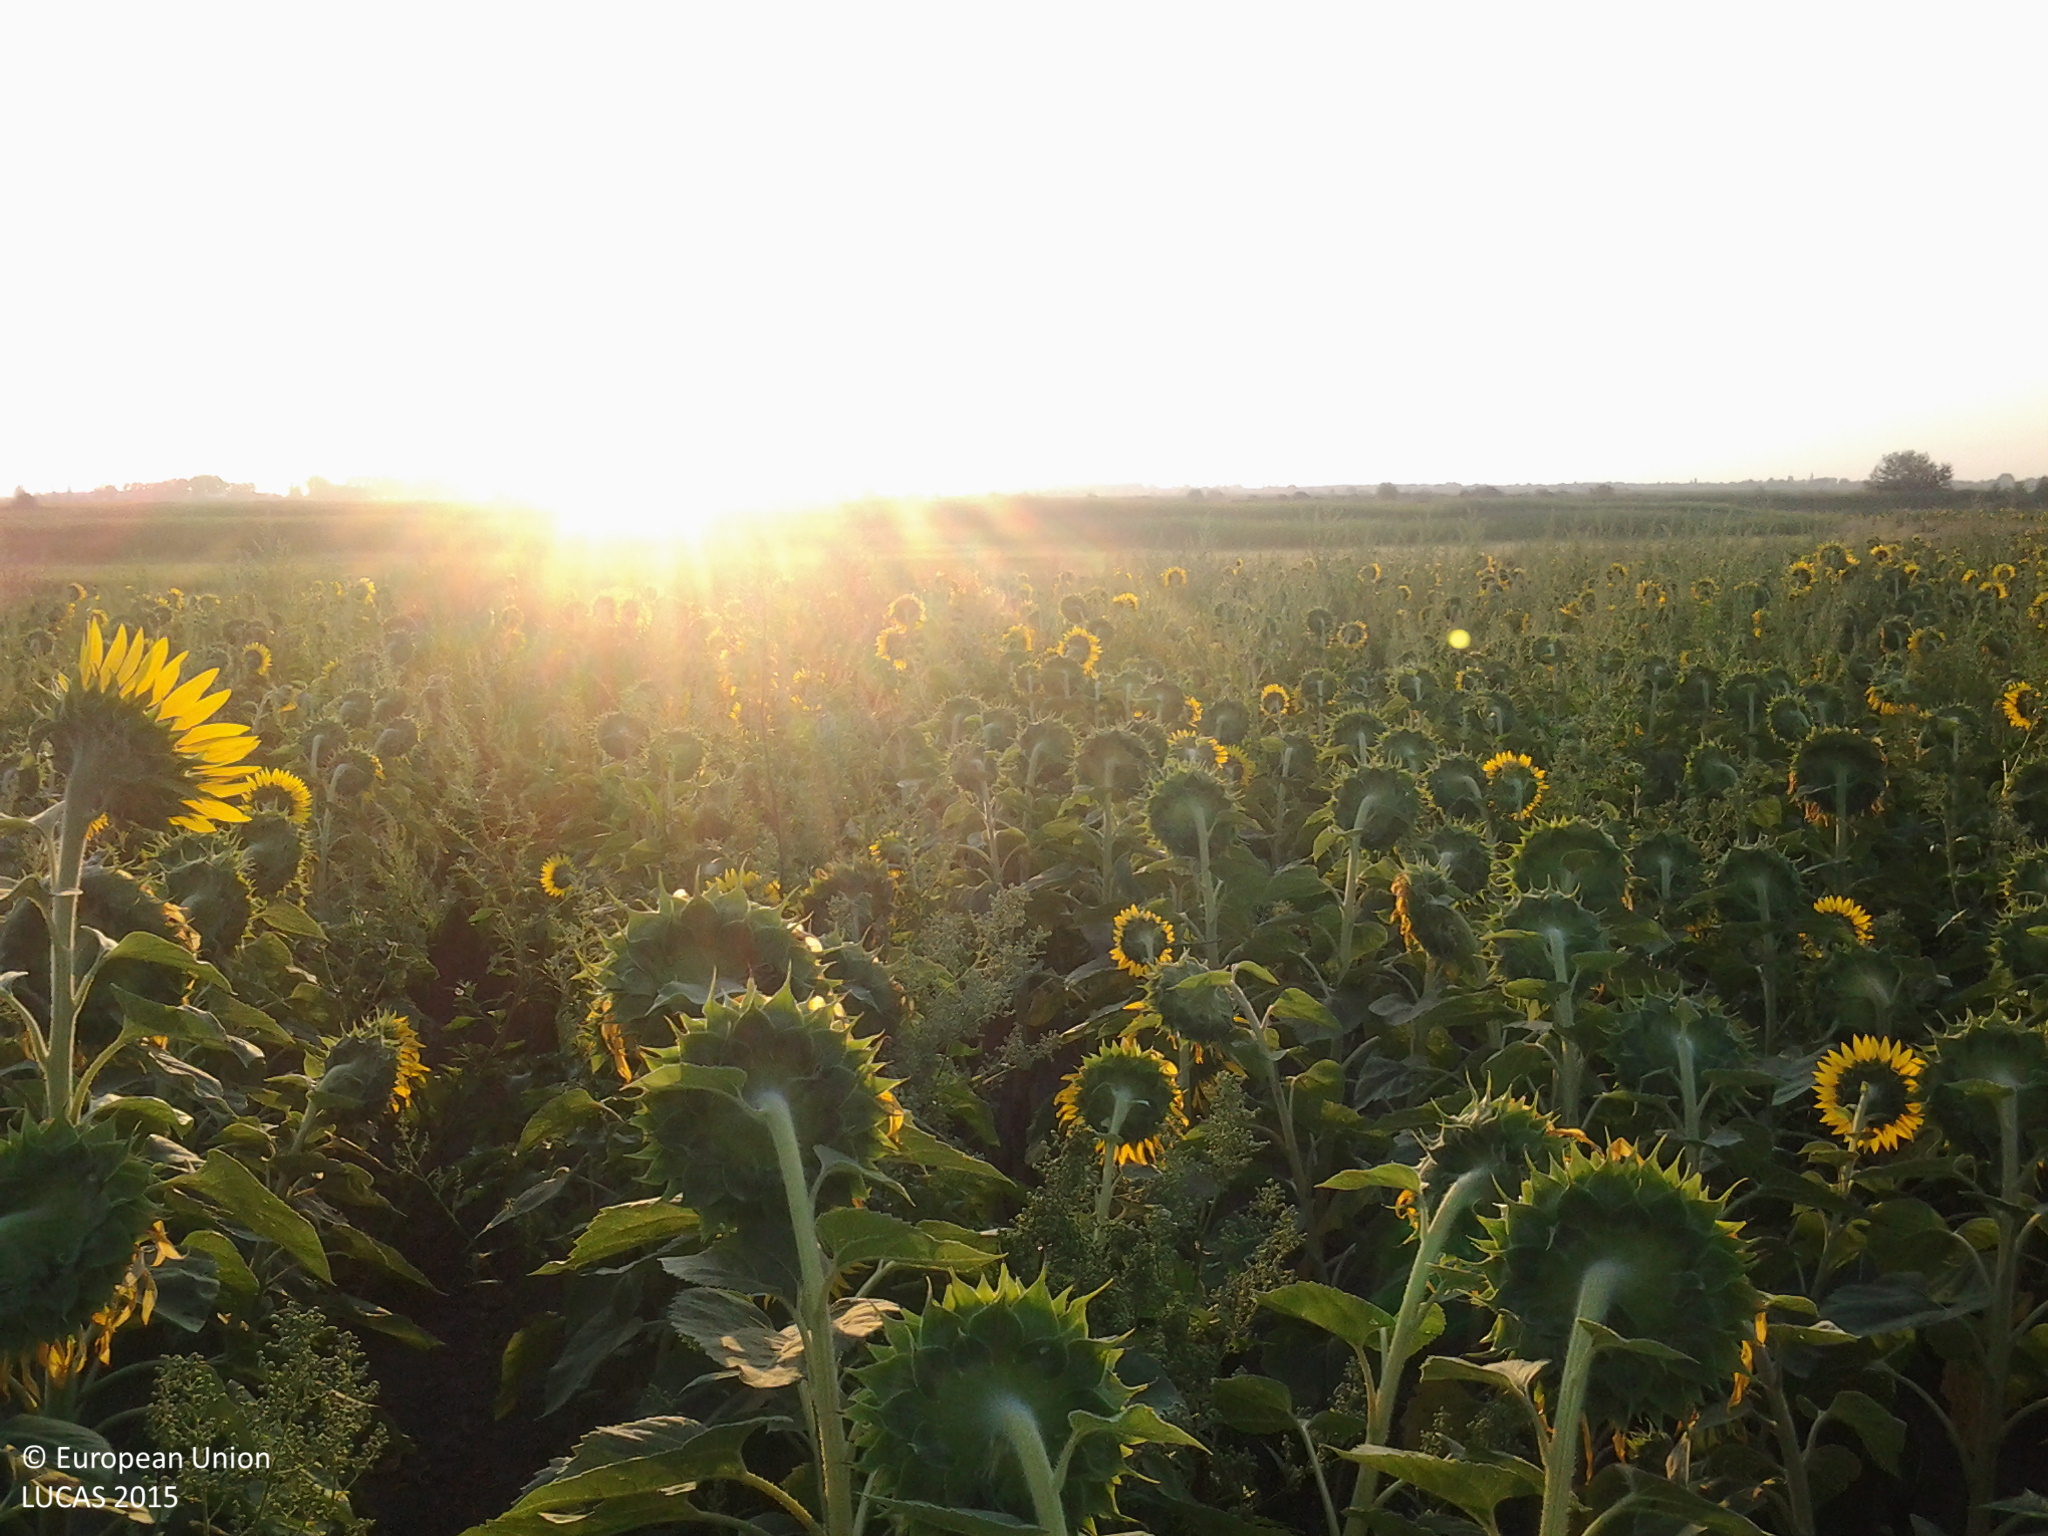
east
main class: Cropland
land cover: Sunflower
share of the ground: > 75 %
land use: Agriculture (excluding fallow land and kitchen gardens)
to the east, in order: Sunflower; Grassland without tree/shrub cover; Inland marshes; Grass margins; Tracks; Grass margins; Inland marshes; Grassland without tree/shrub cover
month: July
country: HU
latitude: 46.8813
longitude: 19.1625
